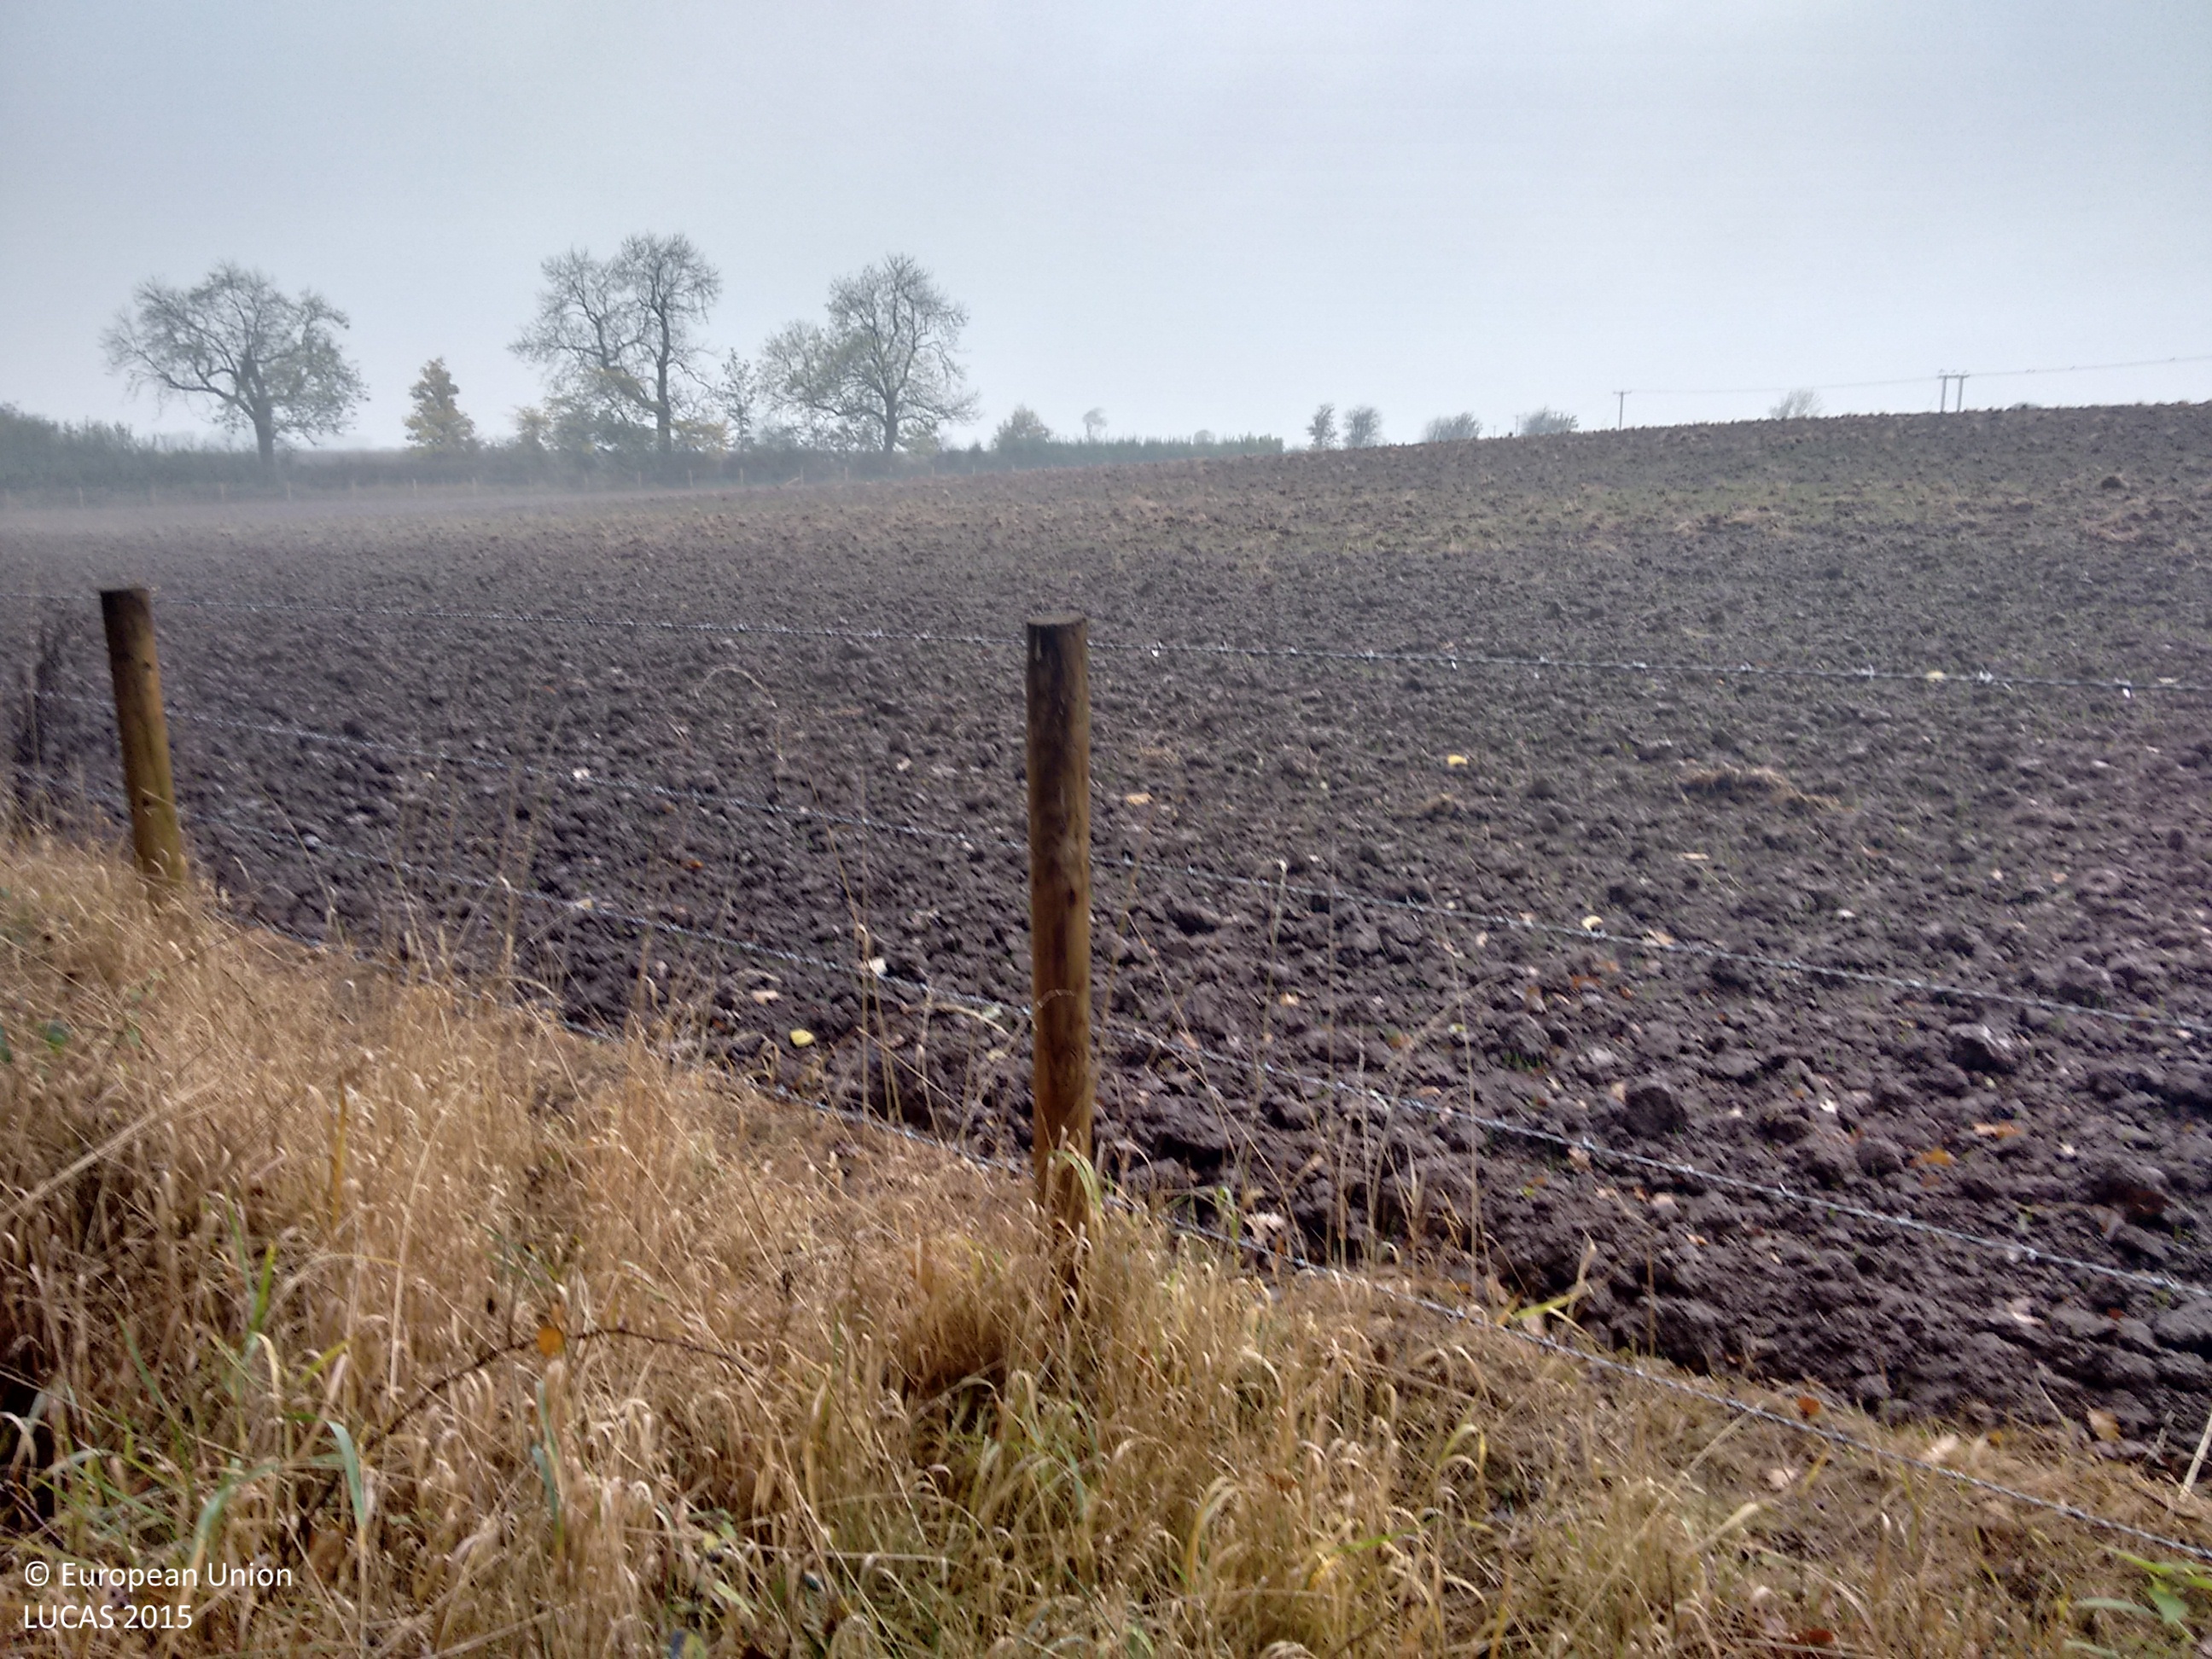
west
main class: Cropland
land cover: Common wheat
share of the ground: < 10 %
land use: Agriculture (excluding fallow land and kitchen gardens)
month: October
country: GB
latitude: 54.5324
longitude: -1.4055
